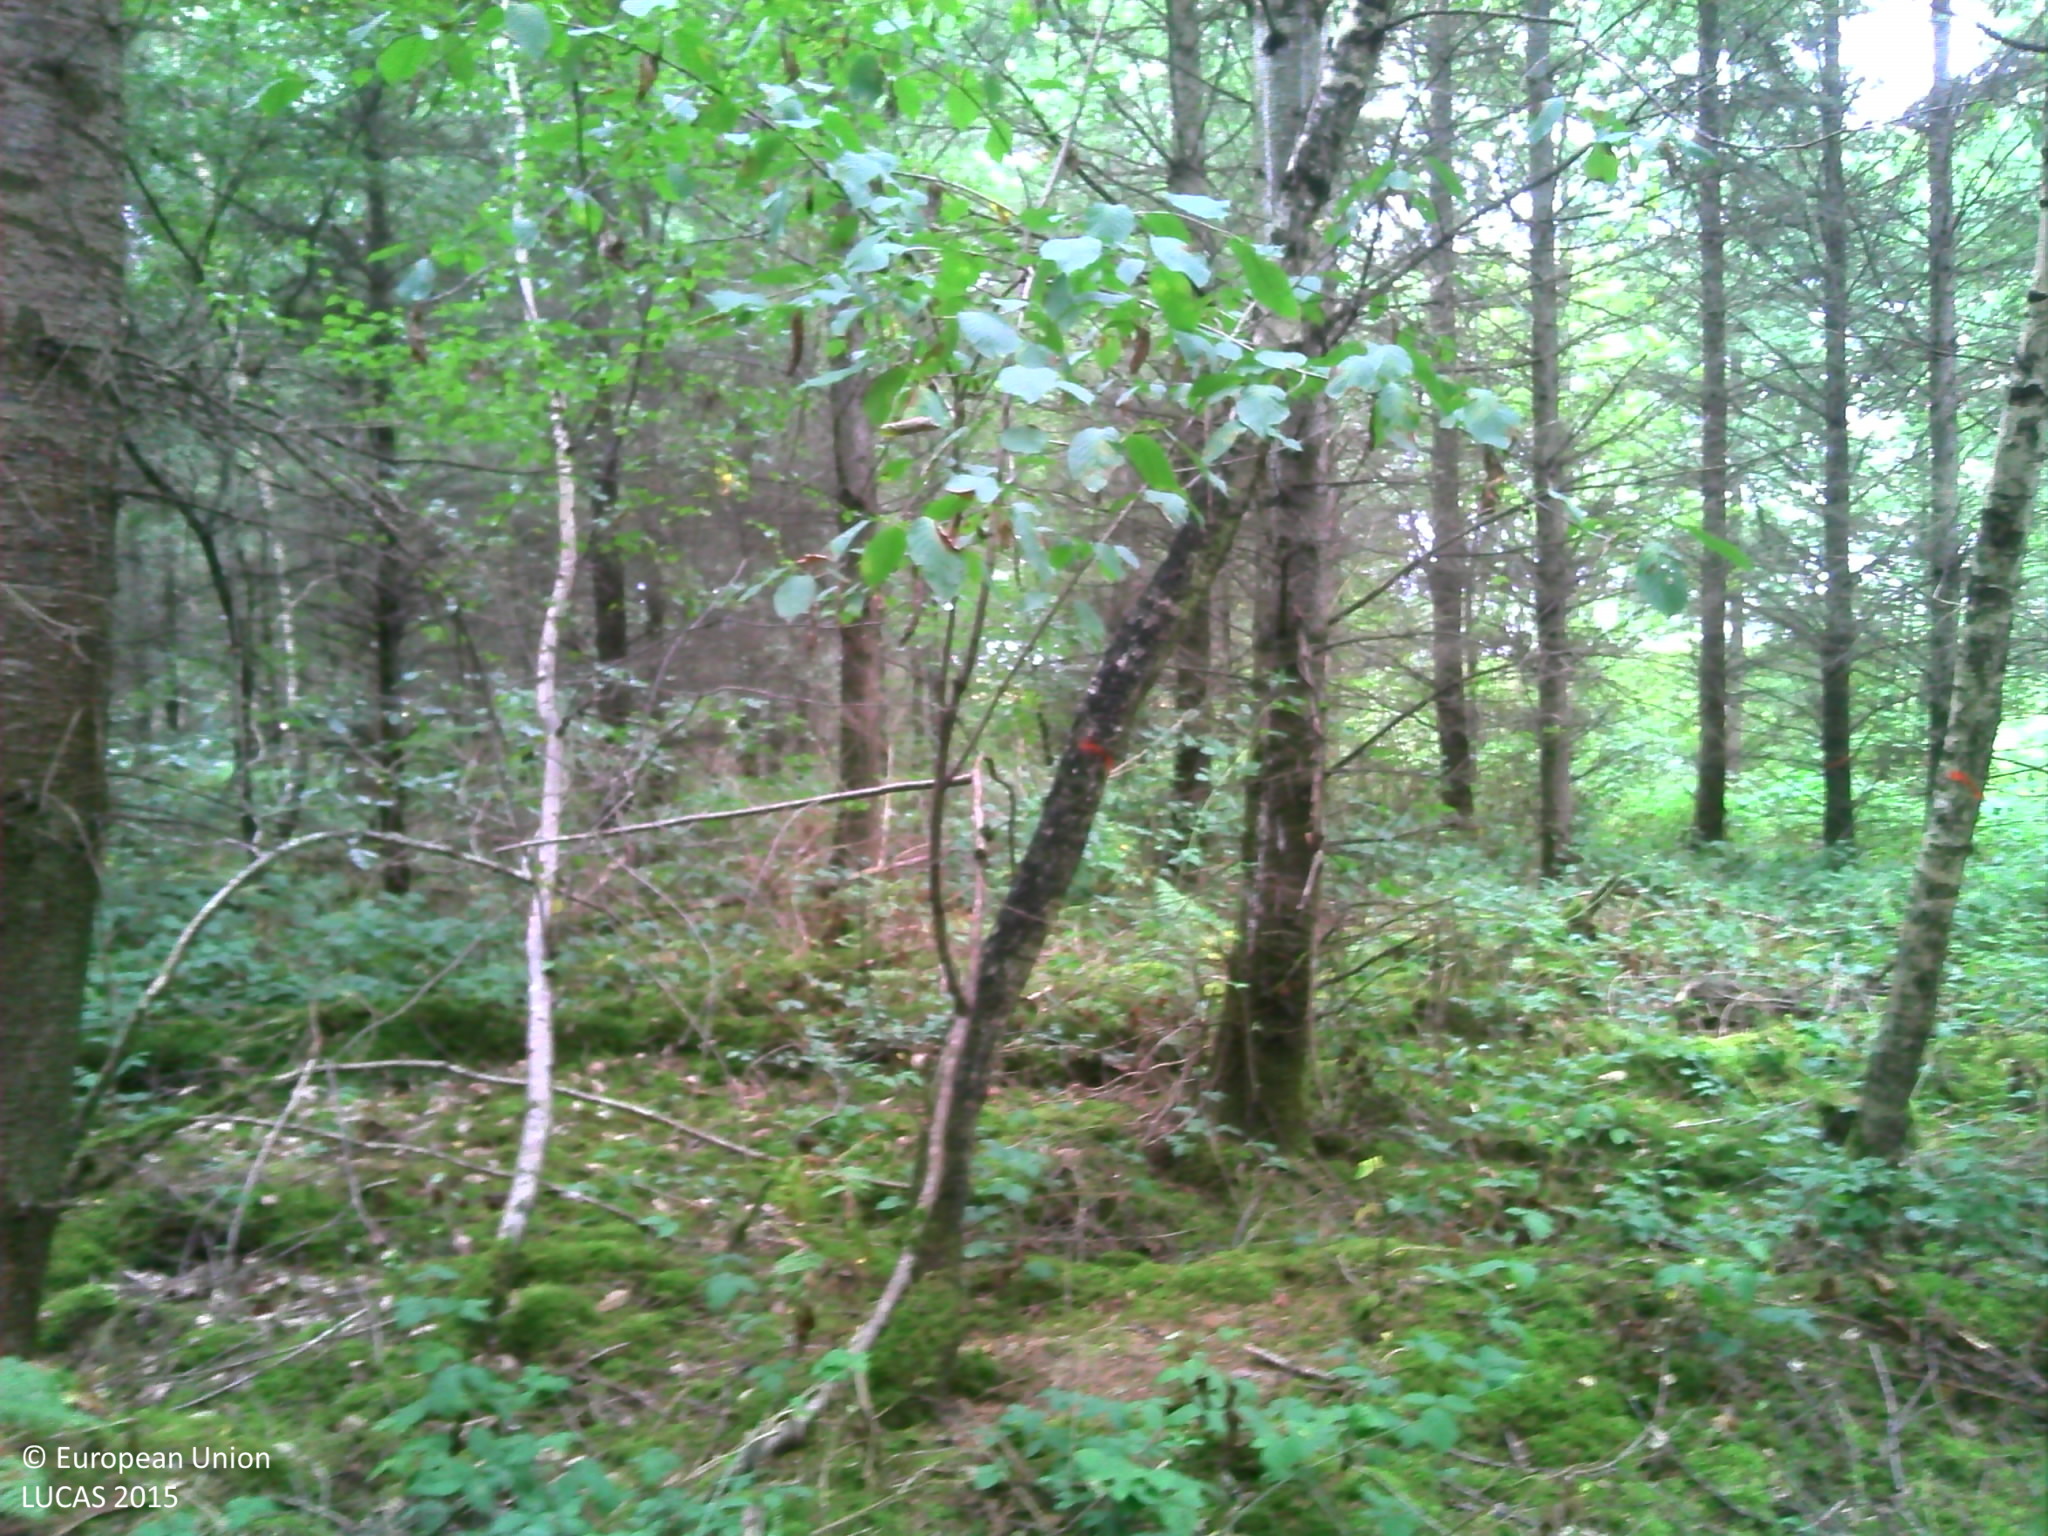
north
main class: Woodland
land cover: Other coniferous woodland
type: exotic forest
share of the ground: > 75 %
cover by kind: coniferous forest trees 80 %, broadleaved forest trees 10 %, shrubs 5 %, lichens and mosses 5 %
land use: Forestry
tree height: > 5 m
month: September
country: FR
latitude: 47.4465
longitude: 4.3360
